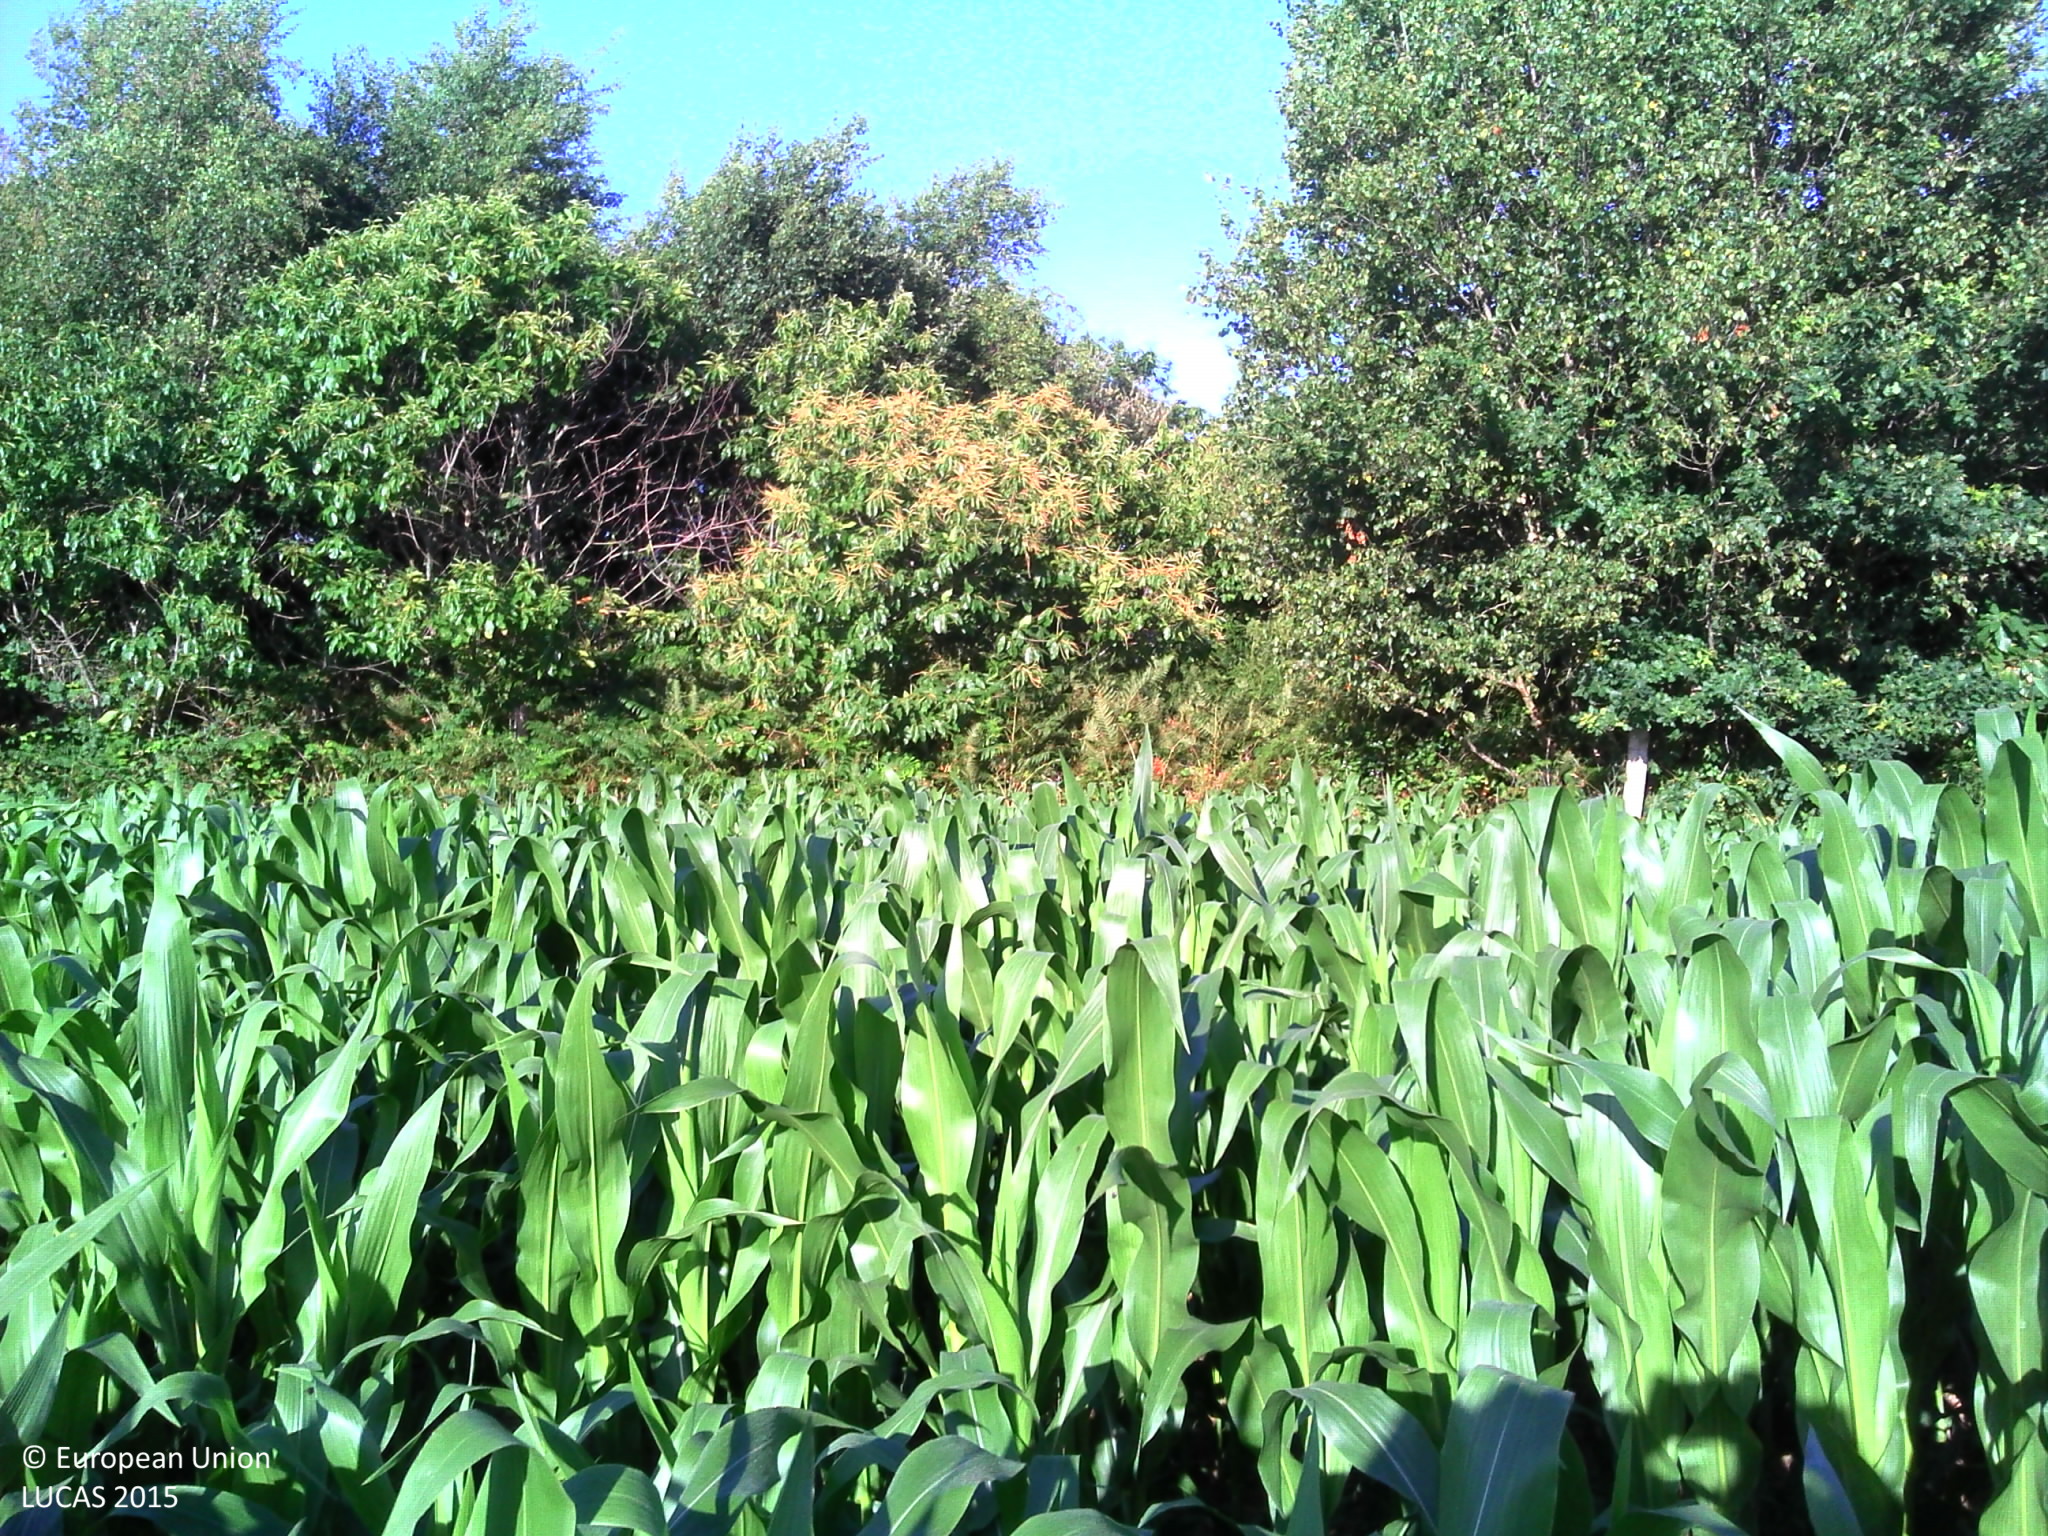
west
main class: Cropland
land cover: Maize
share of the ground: 25 - 50 %
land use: Agriculture (excluding fallow land and kitchen gardens)
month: July
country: FR
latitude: 47.6422
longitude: -1.9632
